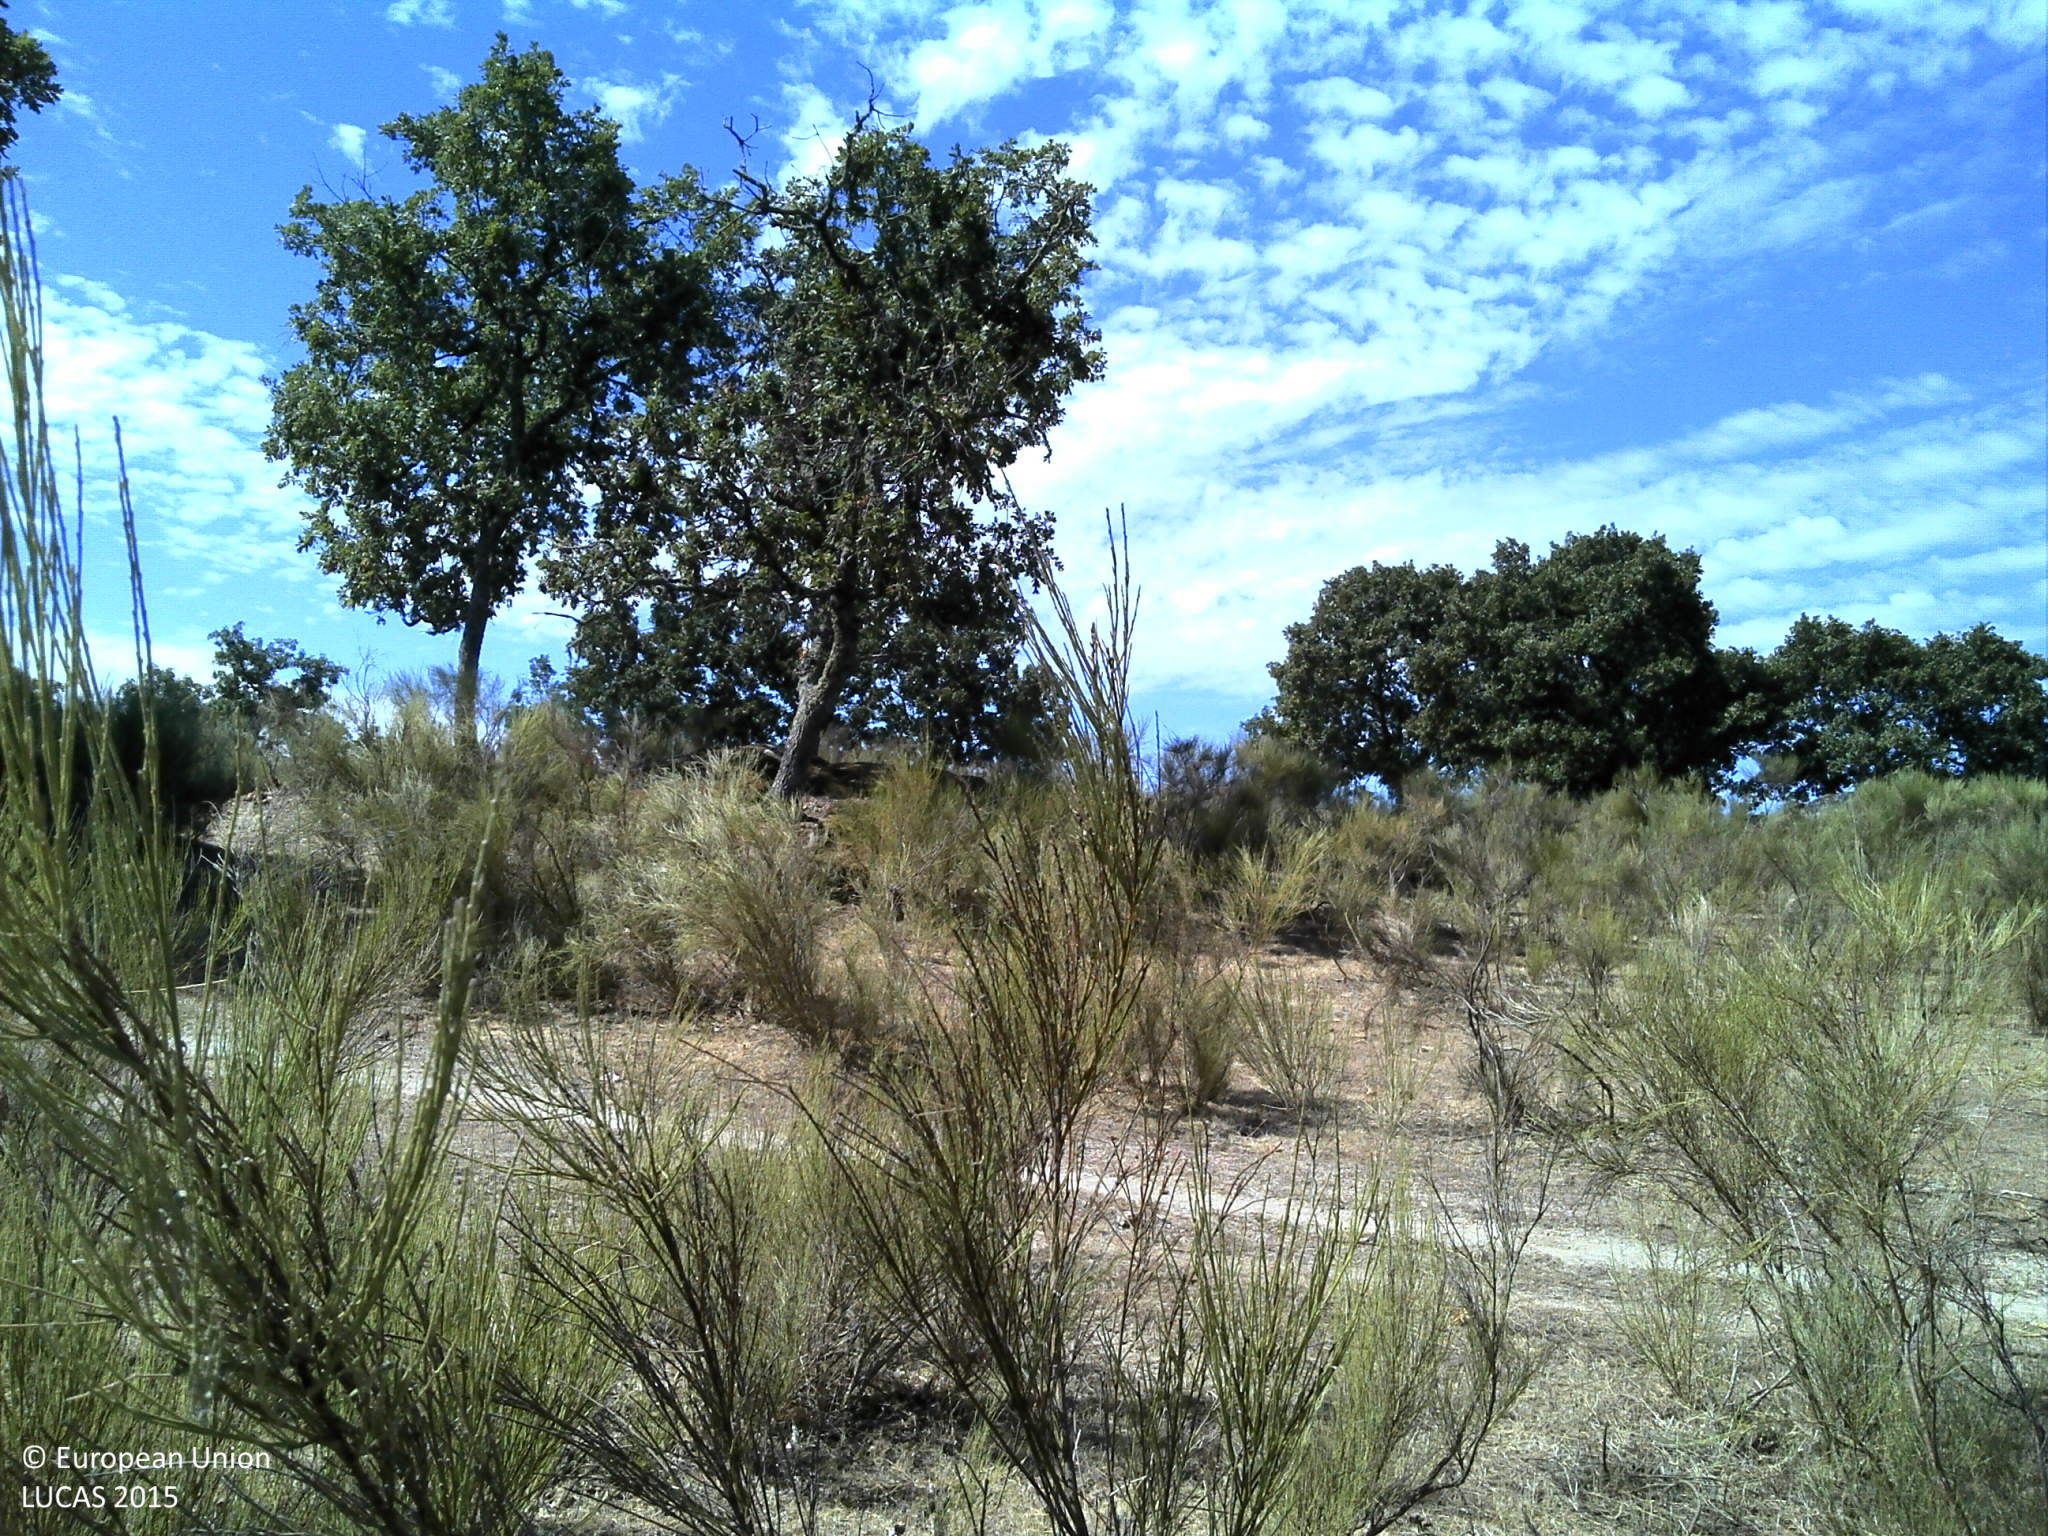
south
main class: Woodland
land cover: Broadleaved woodland
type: broadleaved evergreen forest
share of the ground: 25 - 50 %
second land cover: Shrubland without tree cover
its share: > 75 %
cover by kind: shrubs 70 %, broadleaved forest trees 25 %, herbaceous plants 5 %
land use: Forestry
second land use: Agriculture (excluding fallow land and kitchen gardens)
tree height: > 5 m
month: August
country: PT
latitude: 39.4989
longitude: -7.6684
